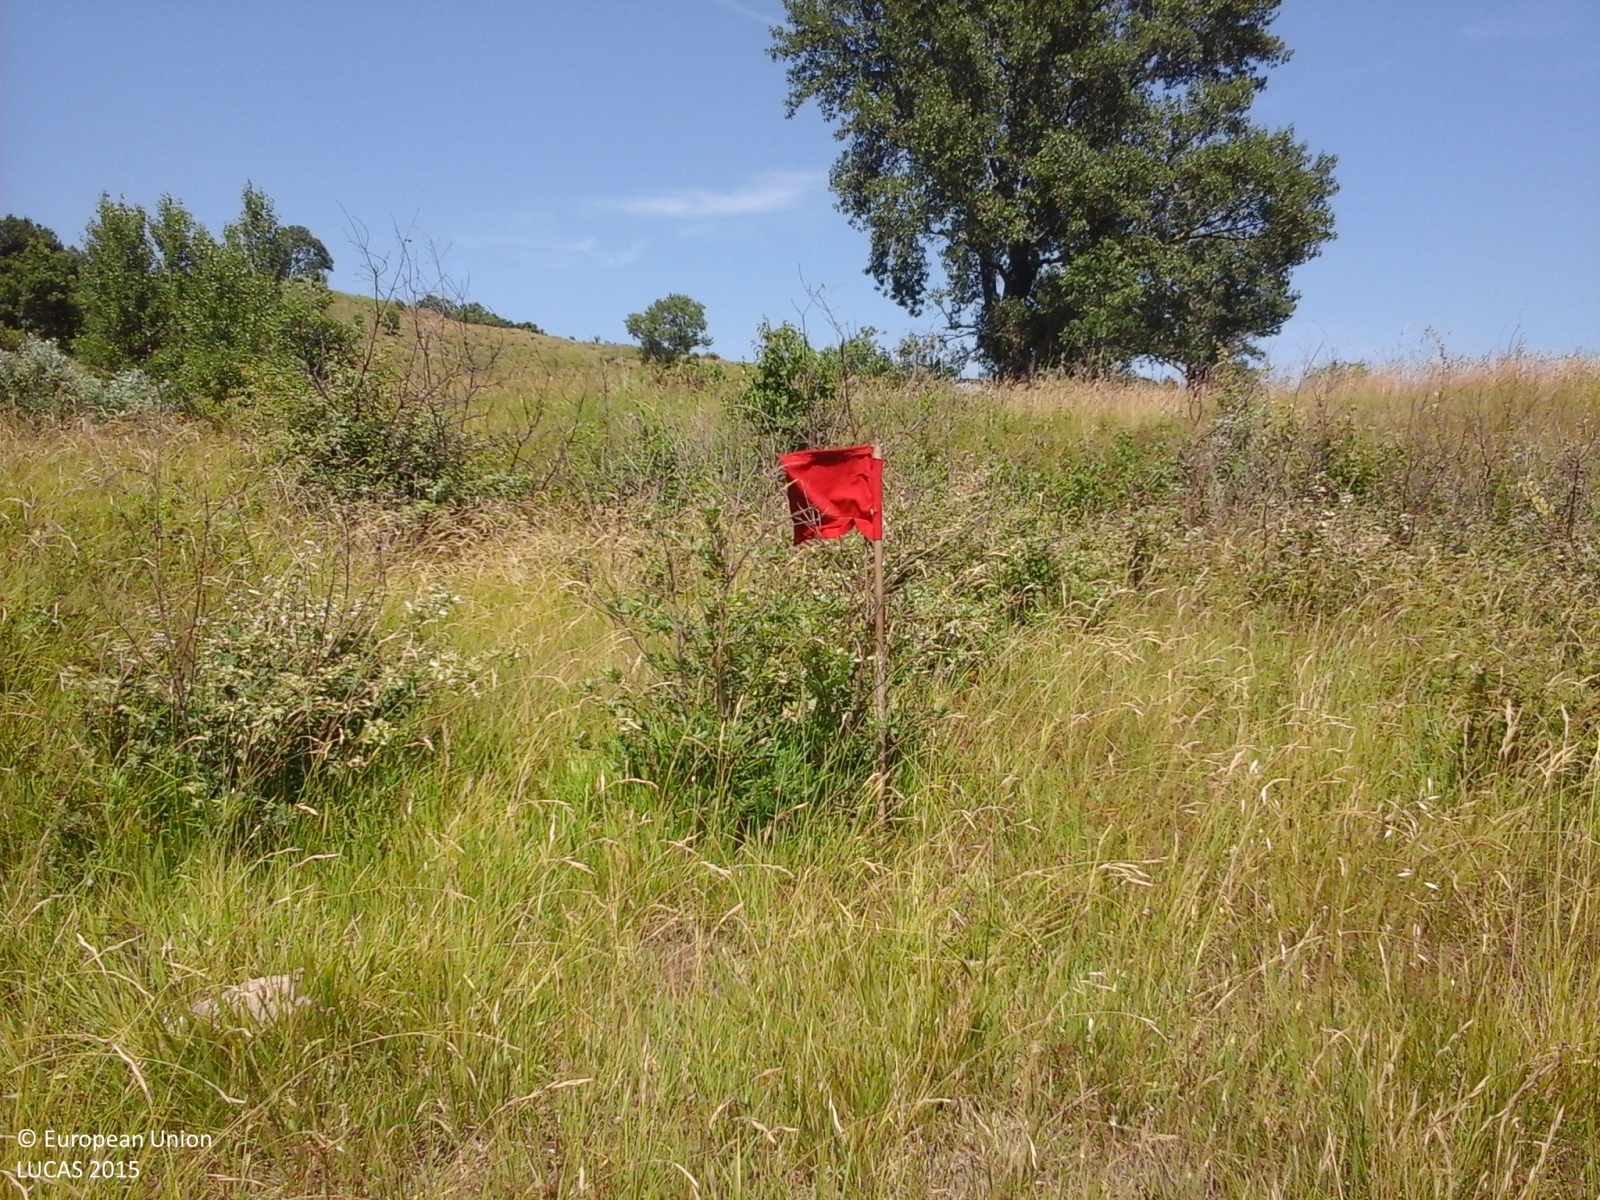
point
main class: Shrubland
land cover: Shrubland with sparse tree cover
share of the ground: > 75 %
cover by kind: herbaceous plants 60 %, shrubs 35 %, broadleaved forest trees 5 %
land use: Abandoned areas
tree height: > 5 m
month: July
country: IT
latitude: 41.0616
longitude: 14.6822
